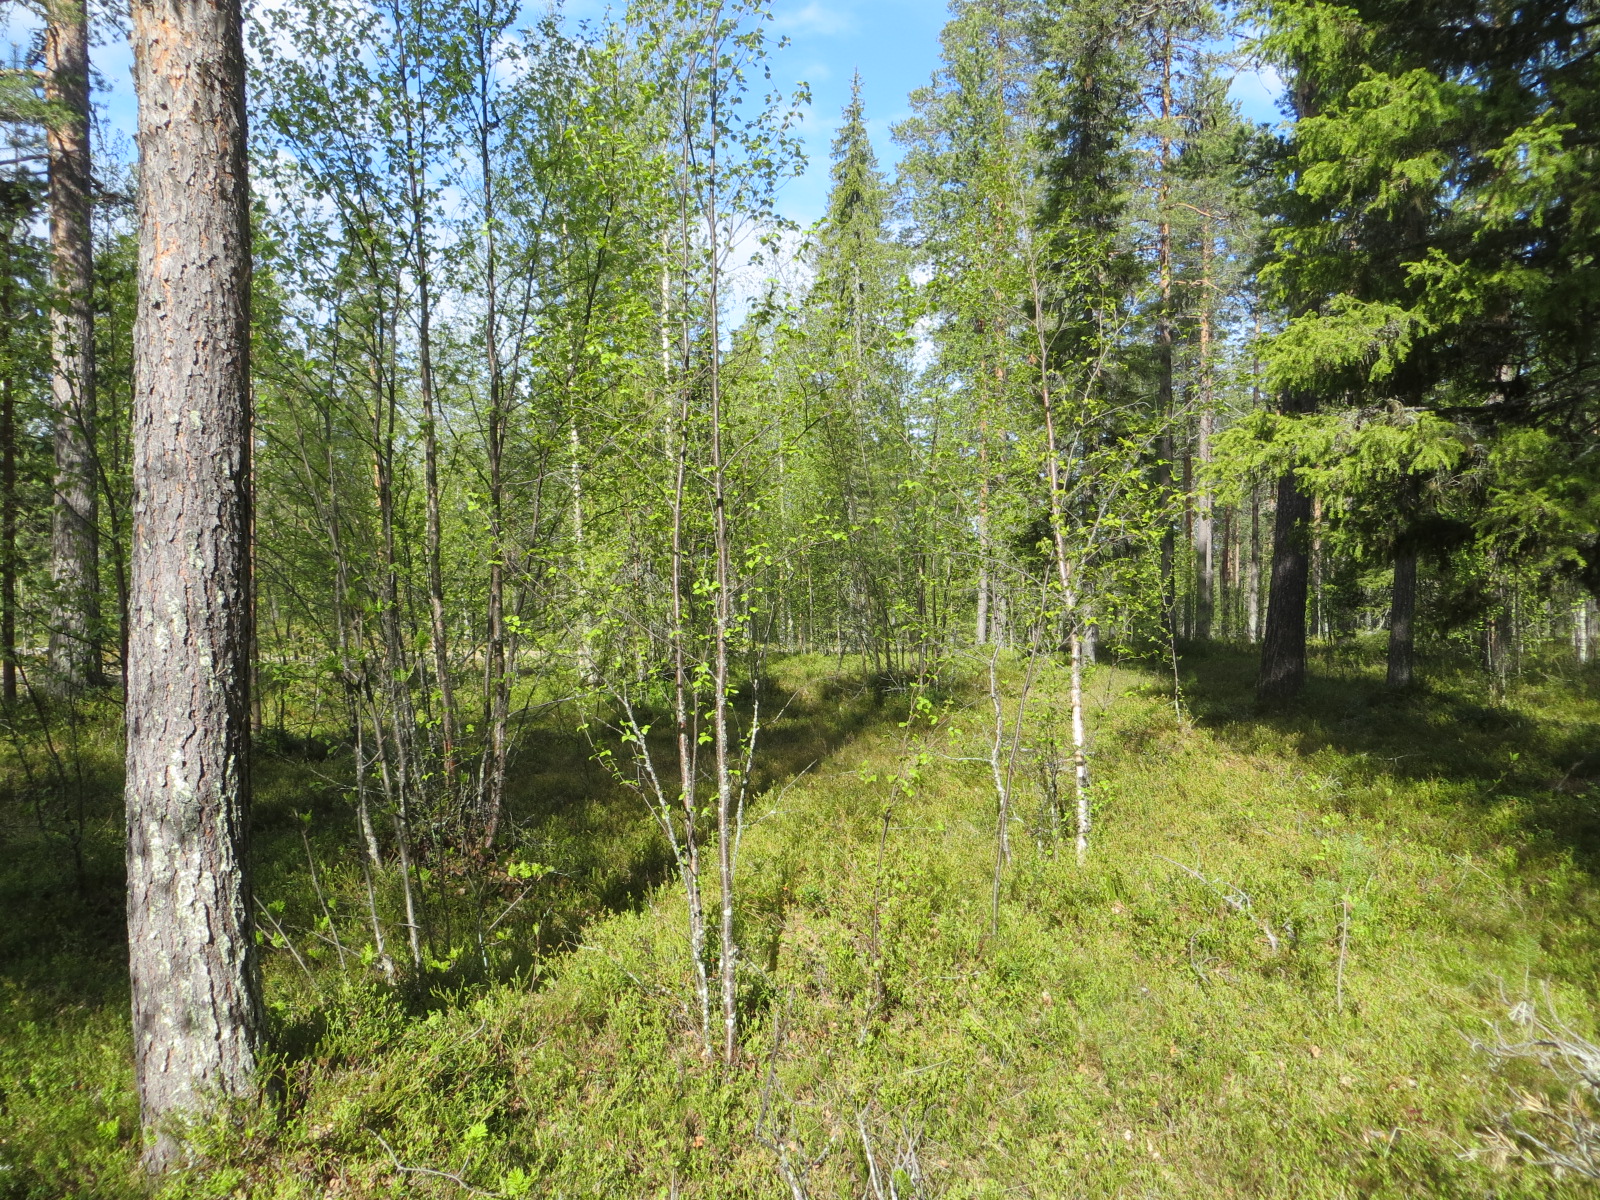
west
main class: Woodland
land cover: Pine dominated mixed woodland
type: boreal forest
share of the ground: 50 - 75 %
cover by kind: coniferous forest trees 50 %, shrubs 30 %, broadleaved forest trees 20 %
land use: Forestry
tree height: > 5 m
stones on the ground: 25 - 50 %
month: June
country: FI
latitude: 67.6149
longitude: 25.2668
